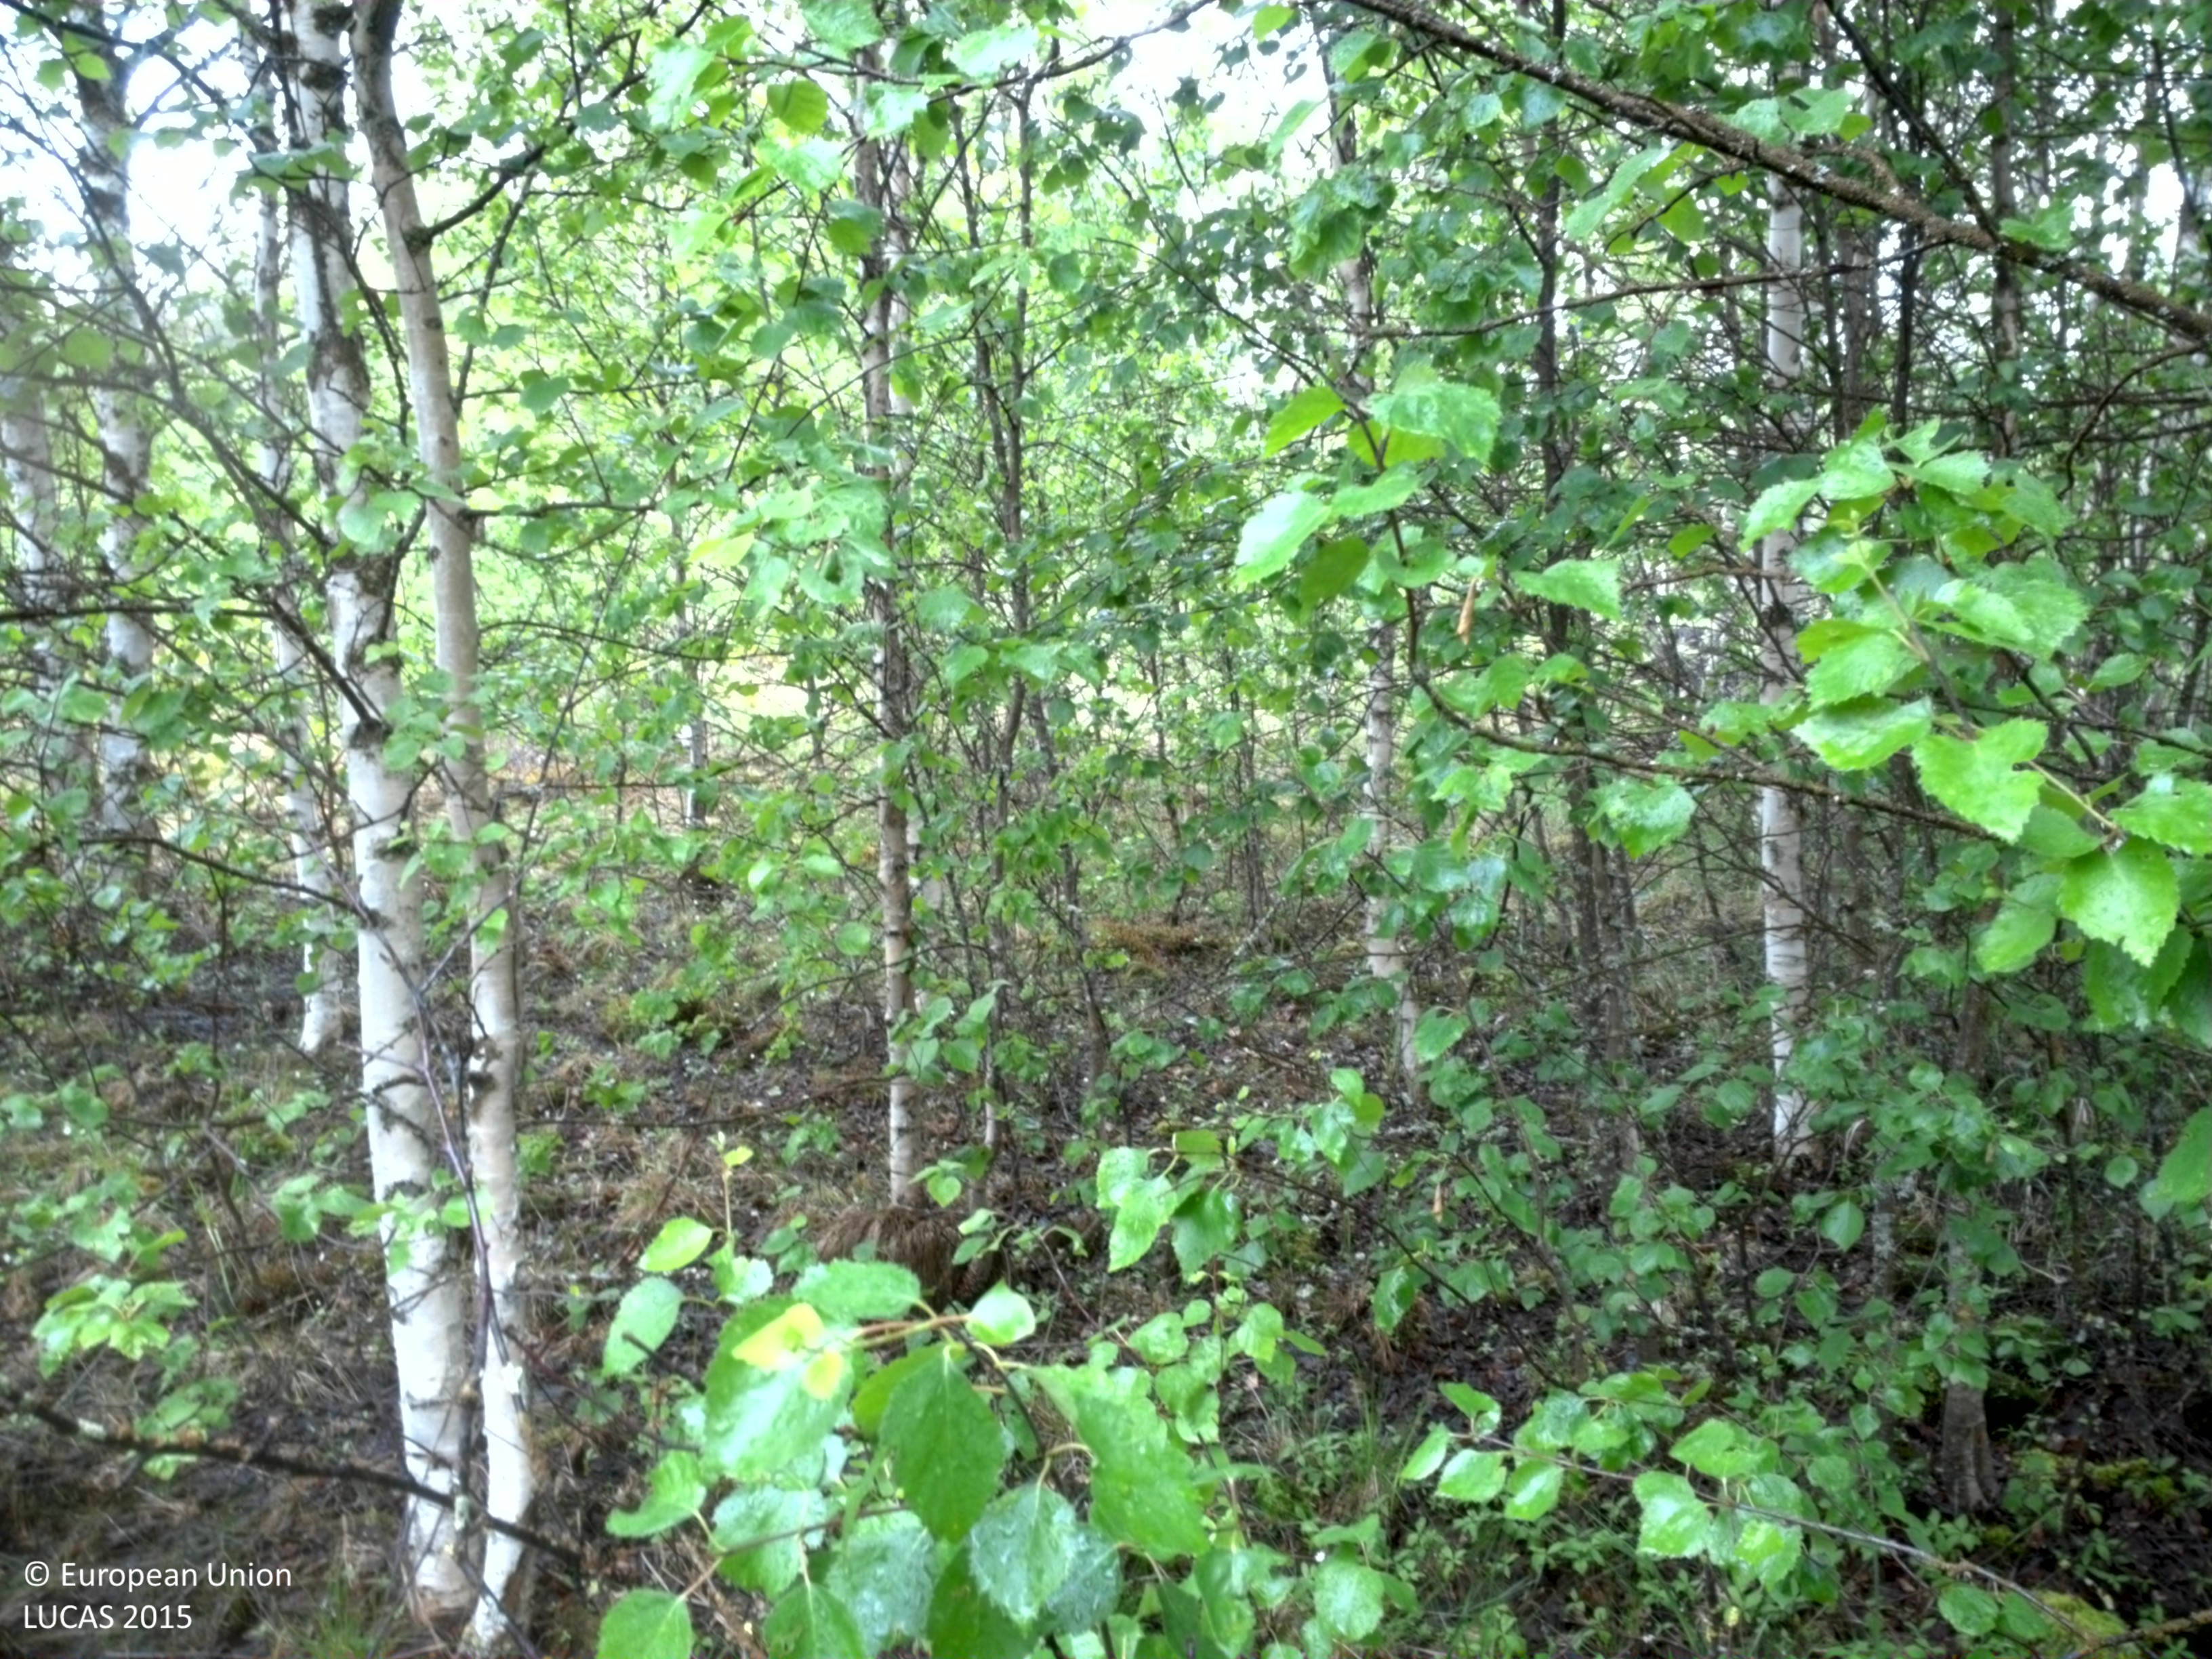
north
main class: Woodland
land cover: Broadleaved woodland
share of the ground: > 75 %
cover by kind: broadleaved forest trees 85 %, shrubs 5 %, herbaceous plants 5 %, lichens and mosses 5 %
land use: Forestry
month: June
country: SE
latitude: 66.3761
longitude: 22.7906
